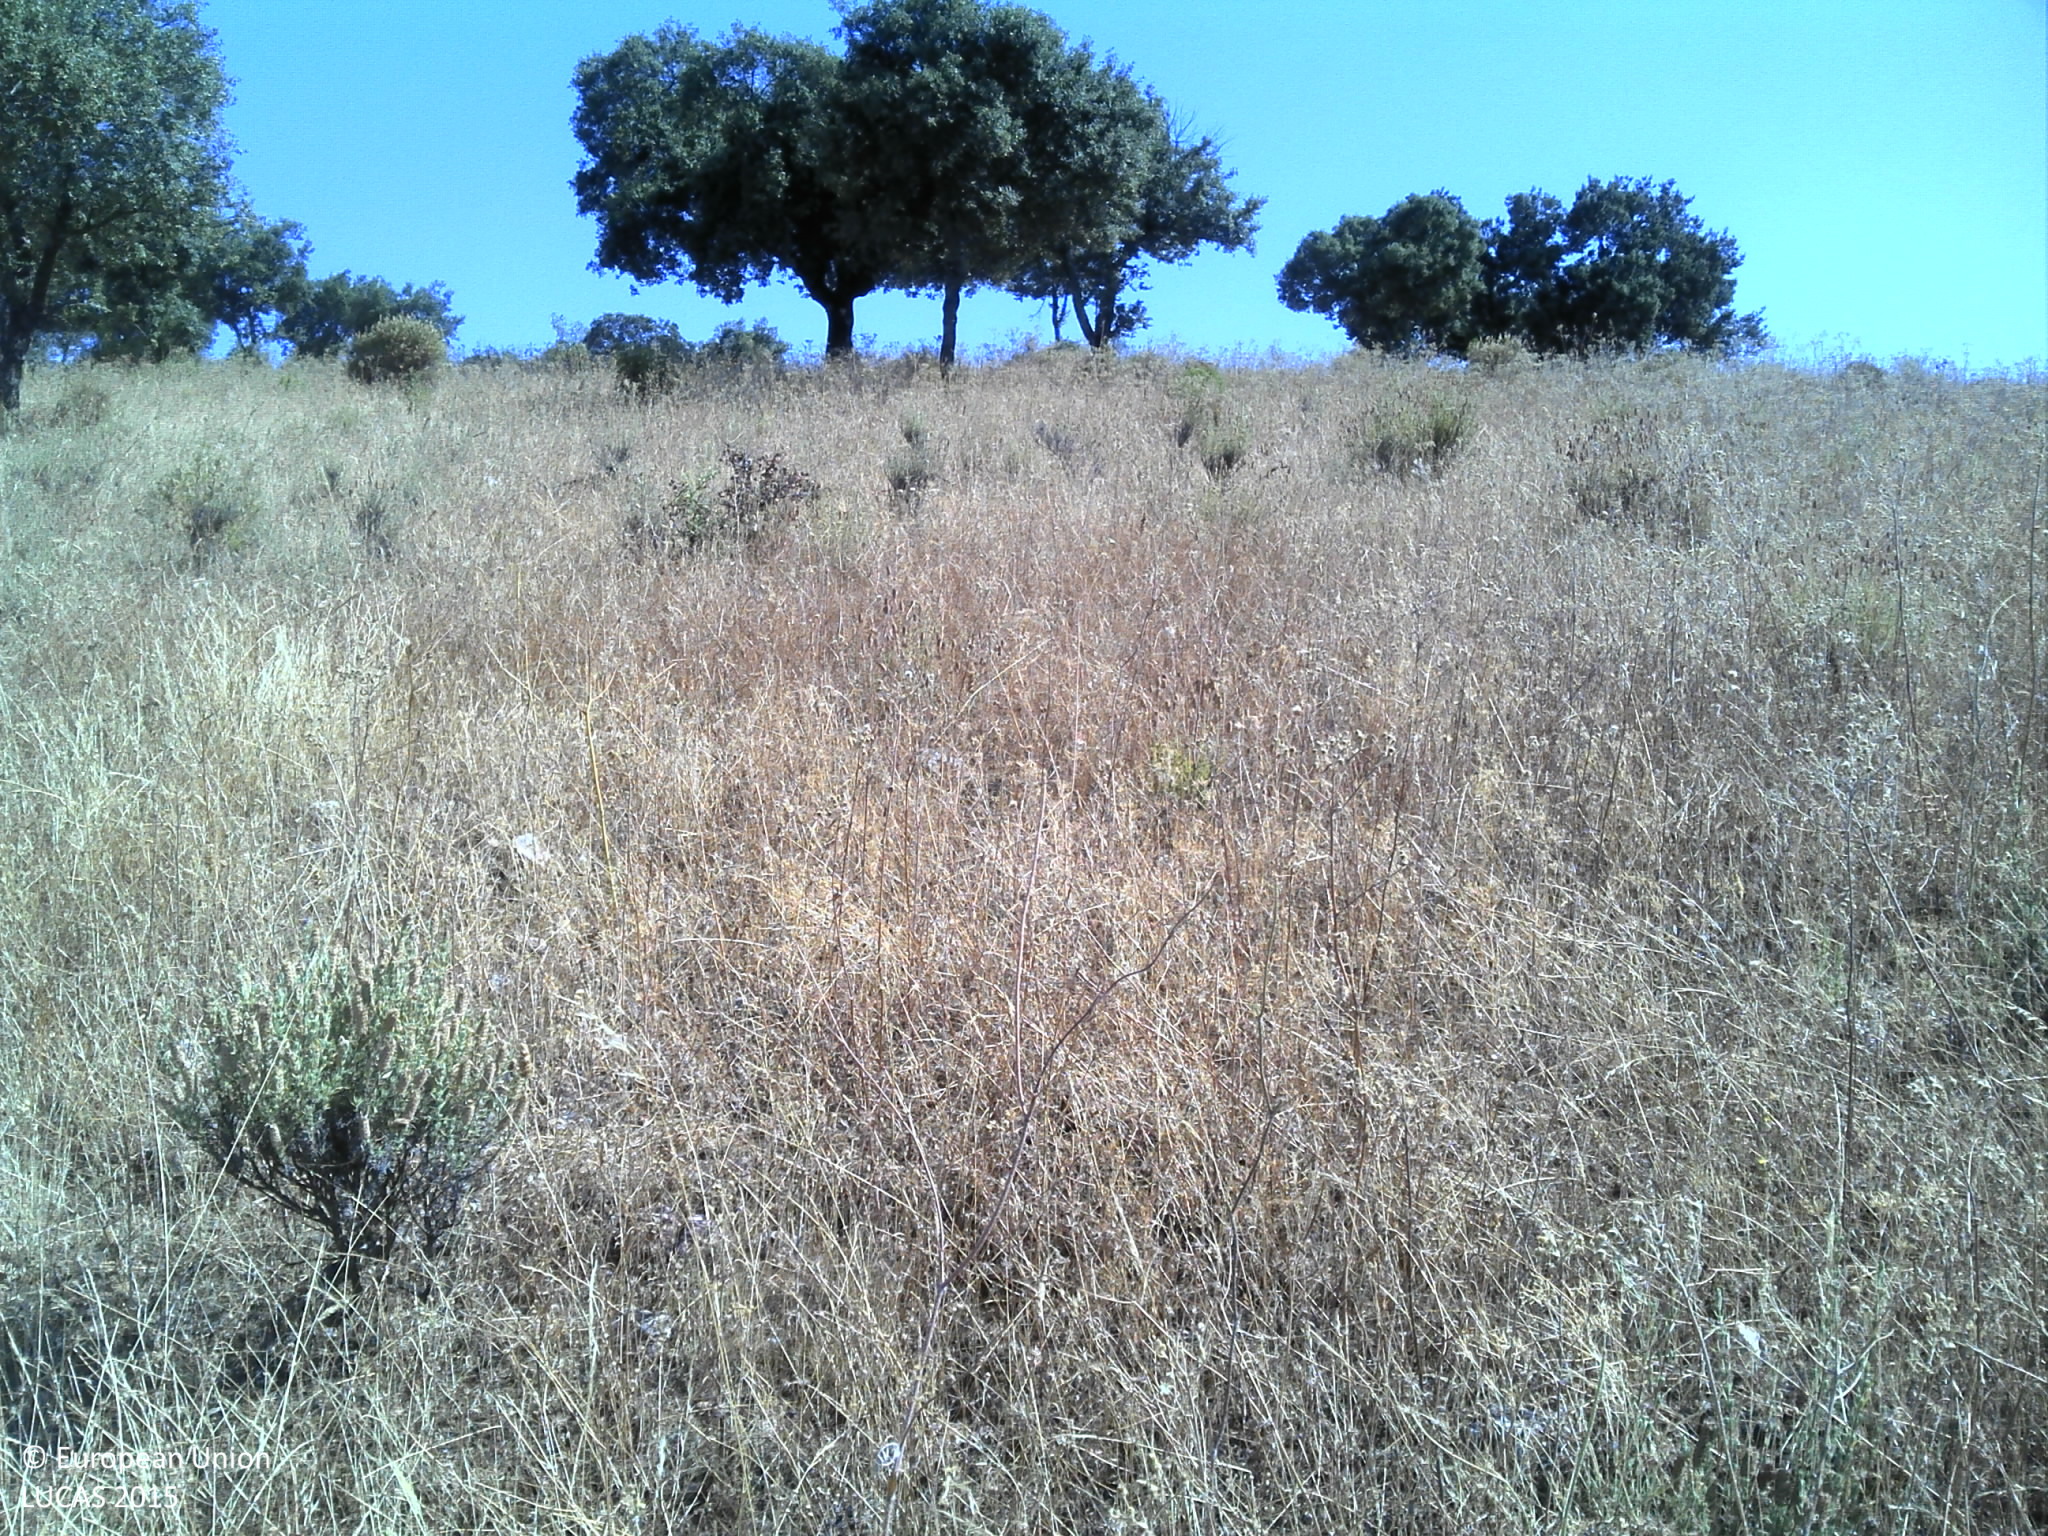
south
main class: Grassland
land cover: Grassland with sparse tree/shrub cover
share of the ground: > 75 %
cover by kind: herbaceous plants 75 %, unconsolidated bare surface 20 %, broadleaved forest trees 5 %
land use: Agriculture (excluding fallow land and kitchen gardens)
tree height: < 5 m
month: June
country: PT
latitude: 38.0072
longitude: -7.2454
